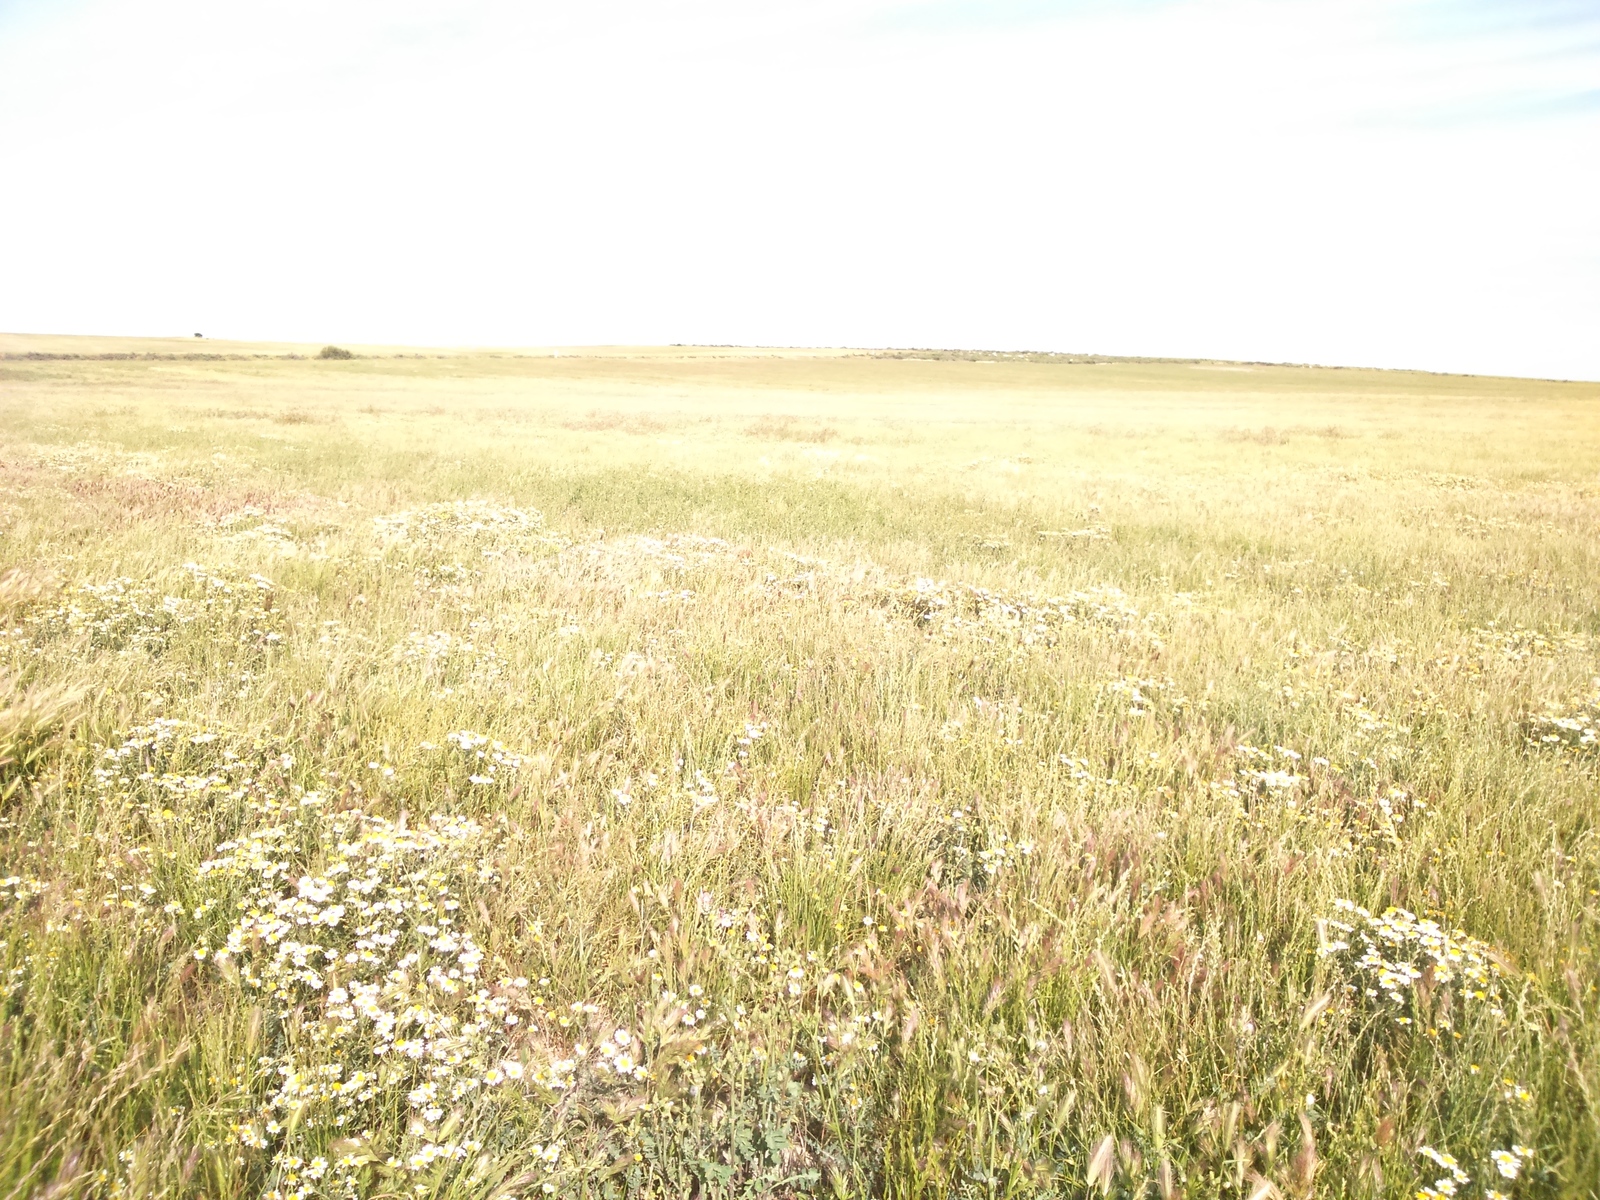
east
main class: Grassland
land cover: Spontaneously vegetated surfaces
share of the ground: > 75 %
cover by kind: herbaceous plants 100 %
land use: Fallow land
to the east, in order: Spontaneously vegetated surfaces
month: April
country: ES
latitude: 41.4641
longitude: -0.2044
